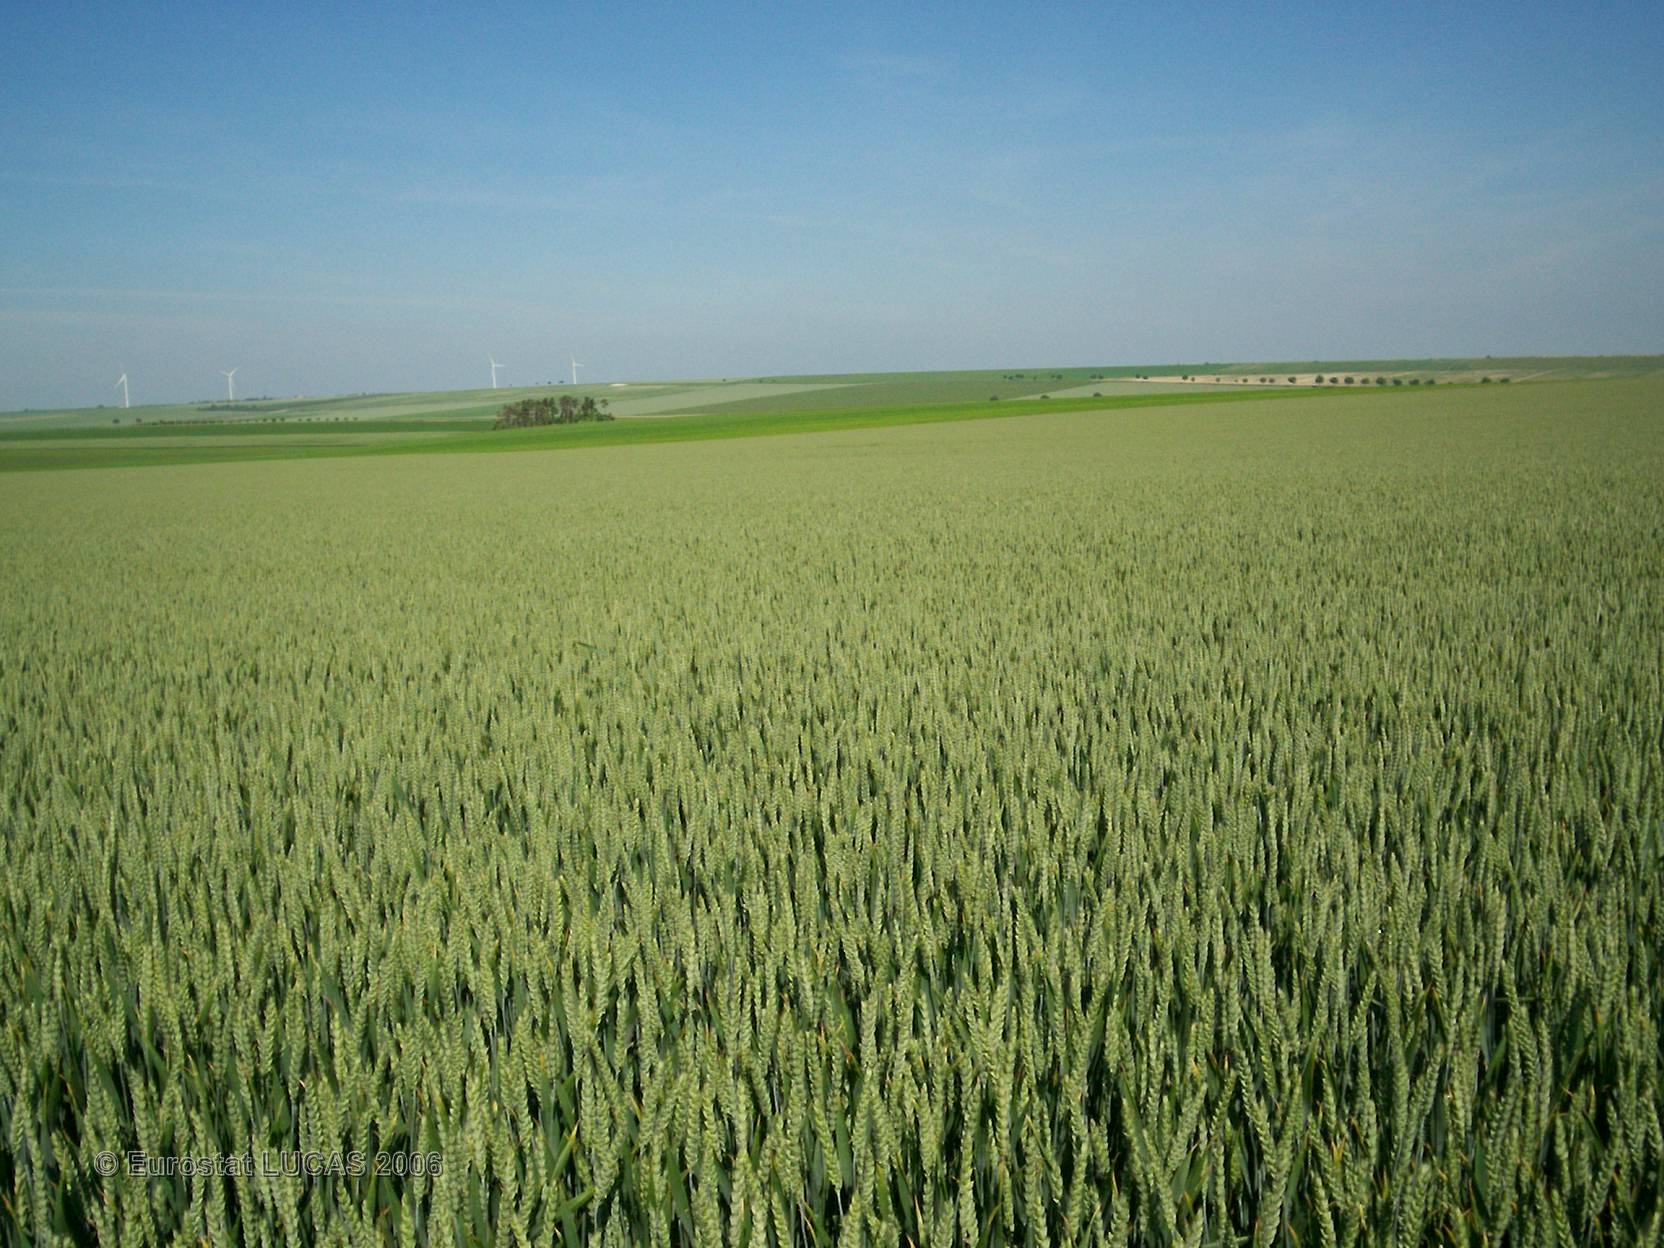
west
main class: Cropland
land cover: Common wheat
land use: Agriculture (excluding fallow land and kitchen gardens)
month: June
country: FR
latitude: 48.8233
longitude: 4.4531
